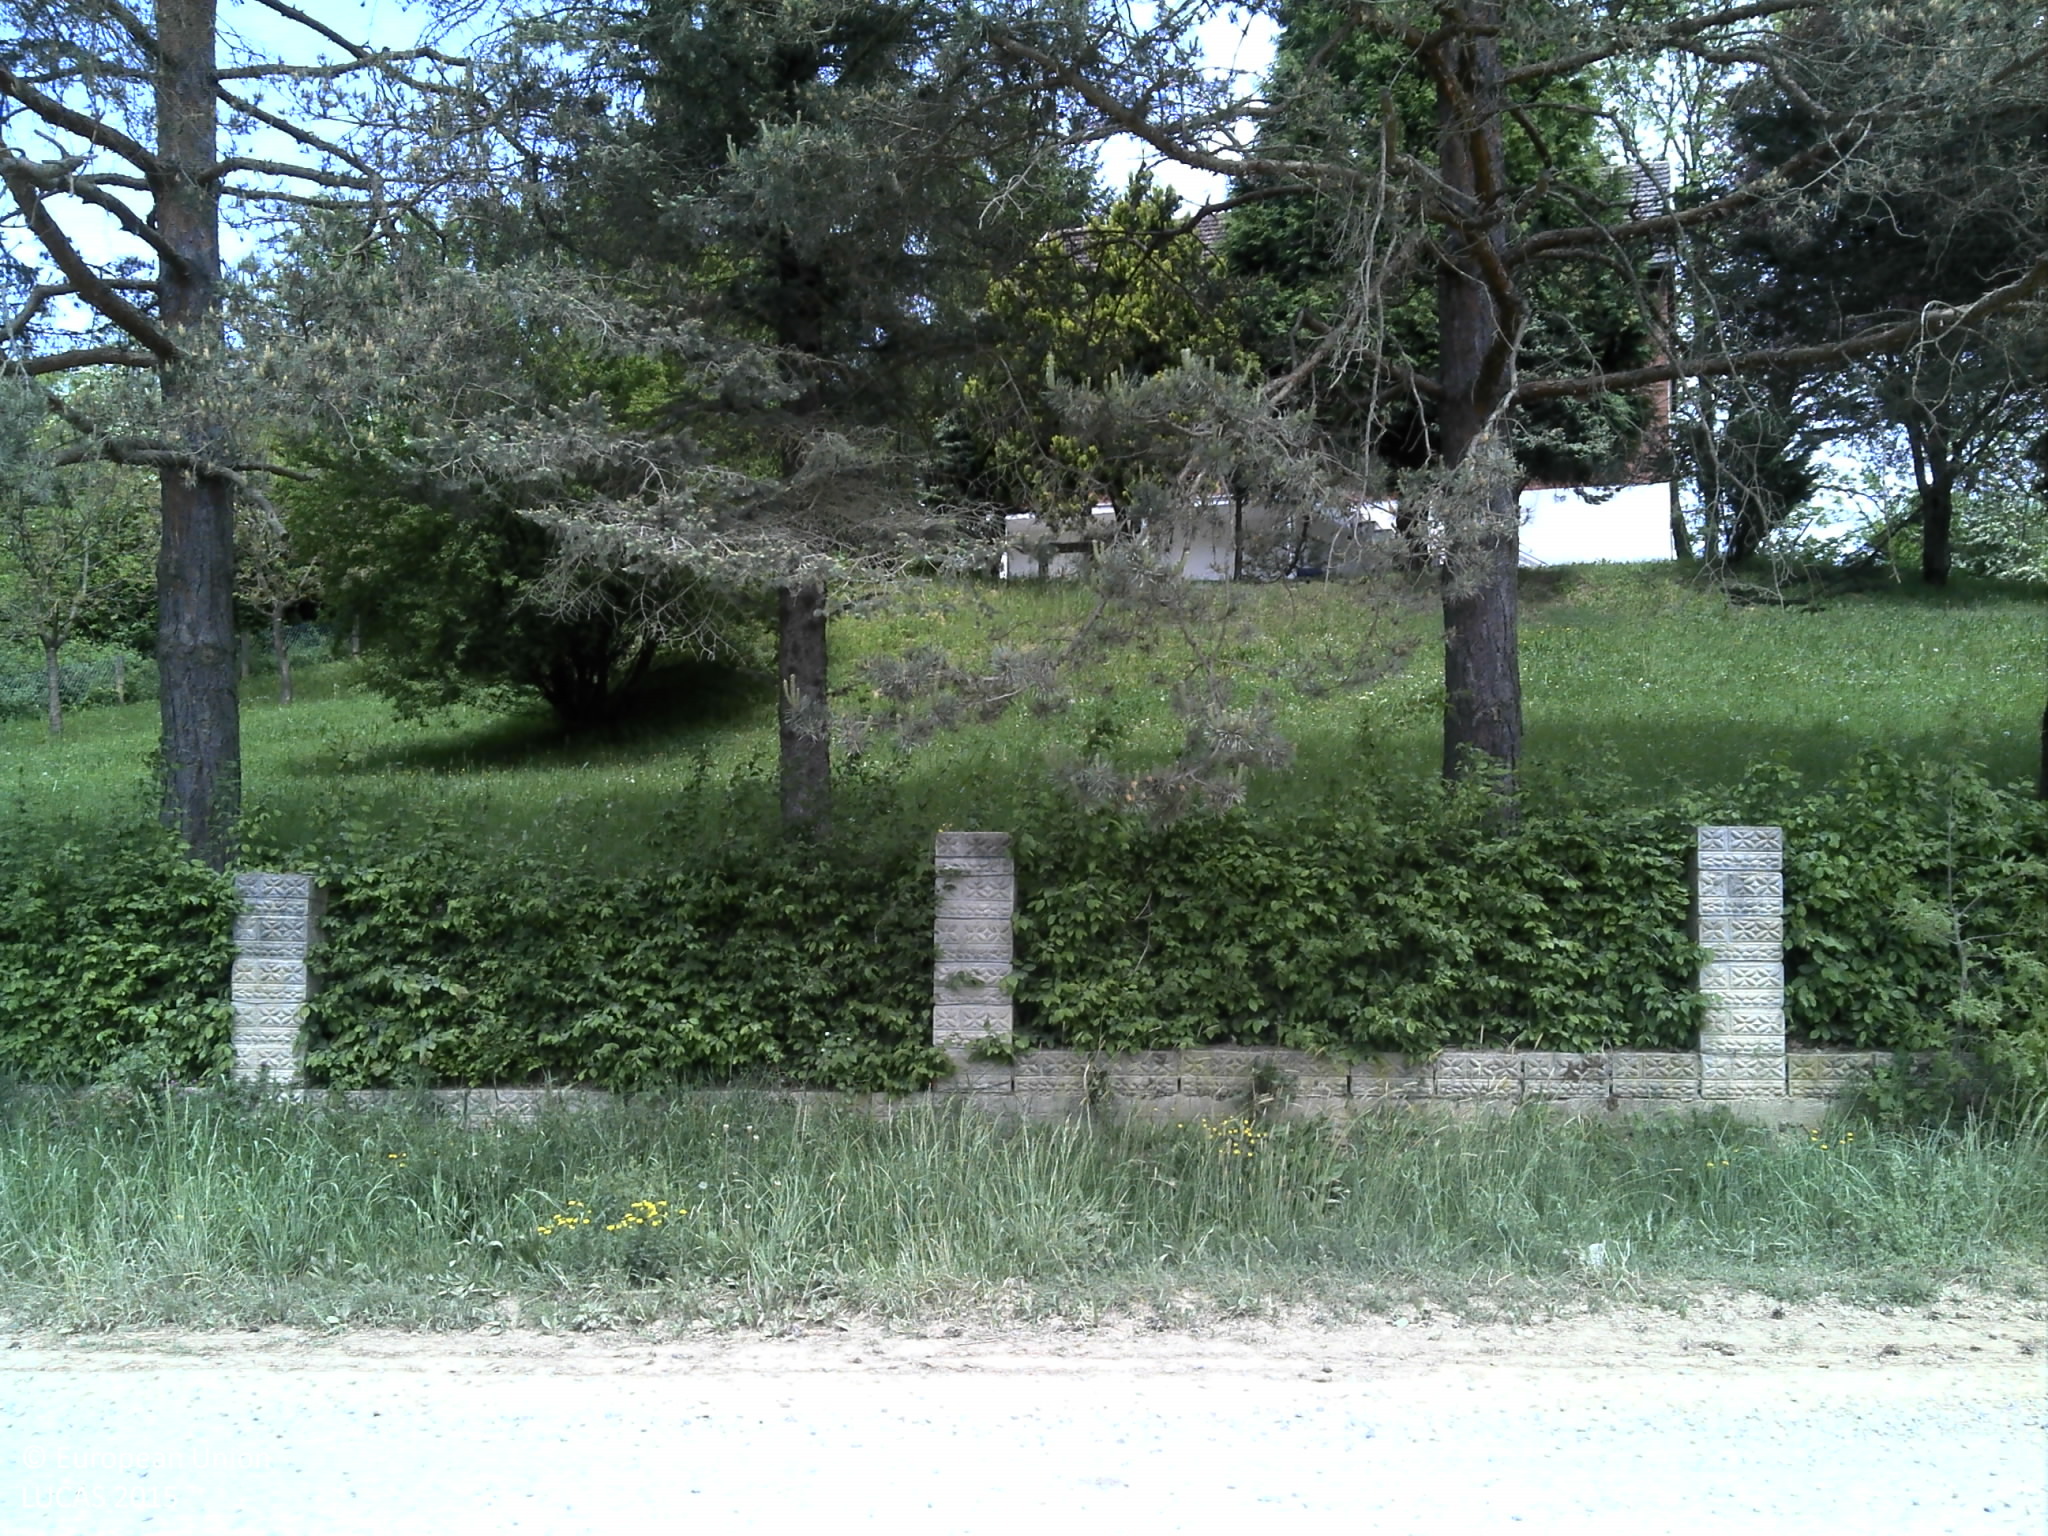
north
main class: Shrubland
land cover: Shrubland with sparse tree cover
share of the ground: > 75 %
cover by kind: shrubs 95 %, broadleaved forest trees 5 %
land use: Semi-natural and natural areas not in use
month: May
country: HR
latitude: 45.3332
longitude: 18.1575
